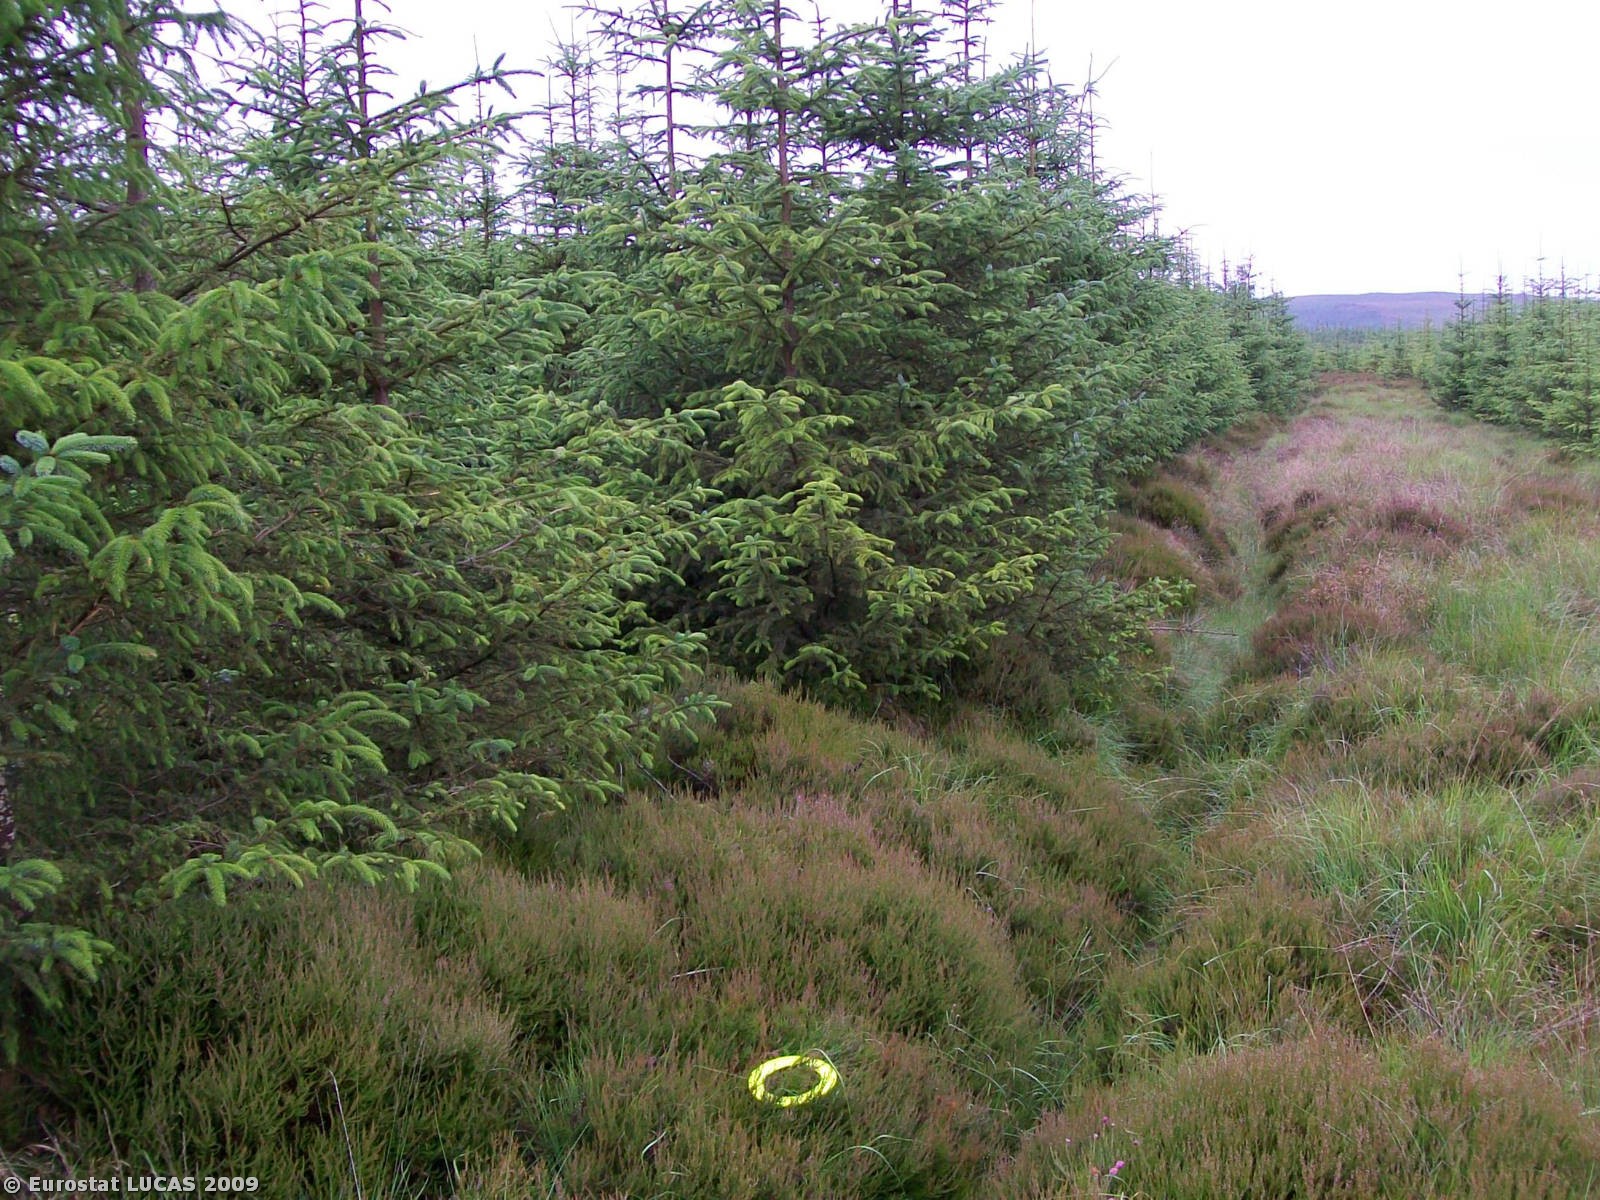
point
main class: Woodland
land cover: Coniferous woodland
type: plantations and self-sown exotic forest
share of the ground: > 75 %
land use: Forestry
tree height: > 5 m
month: July
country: GB
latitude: 55.1261
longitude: -3.9685
